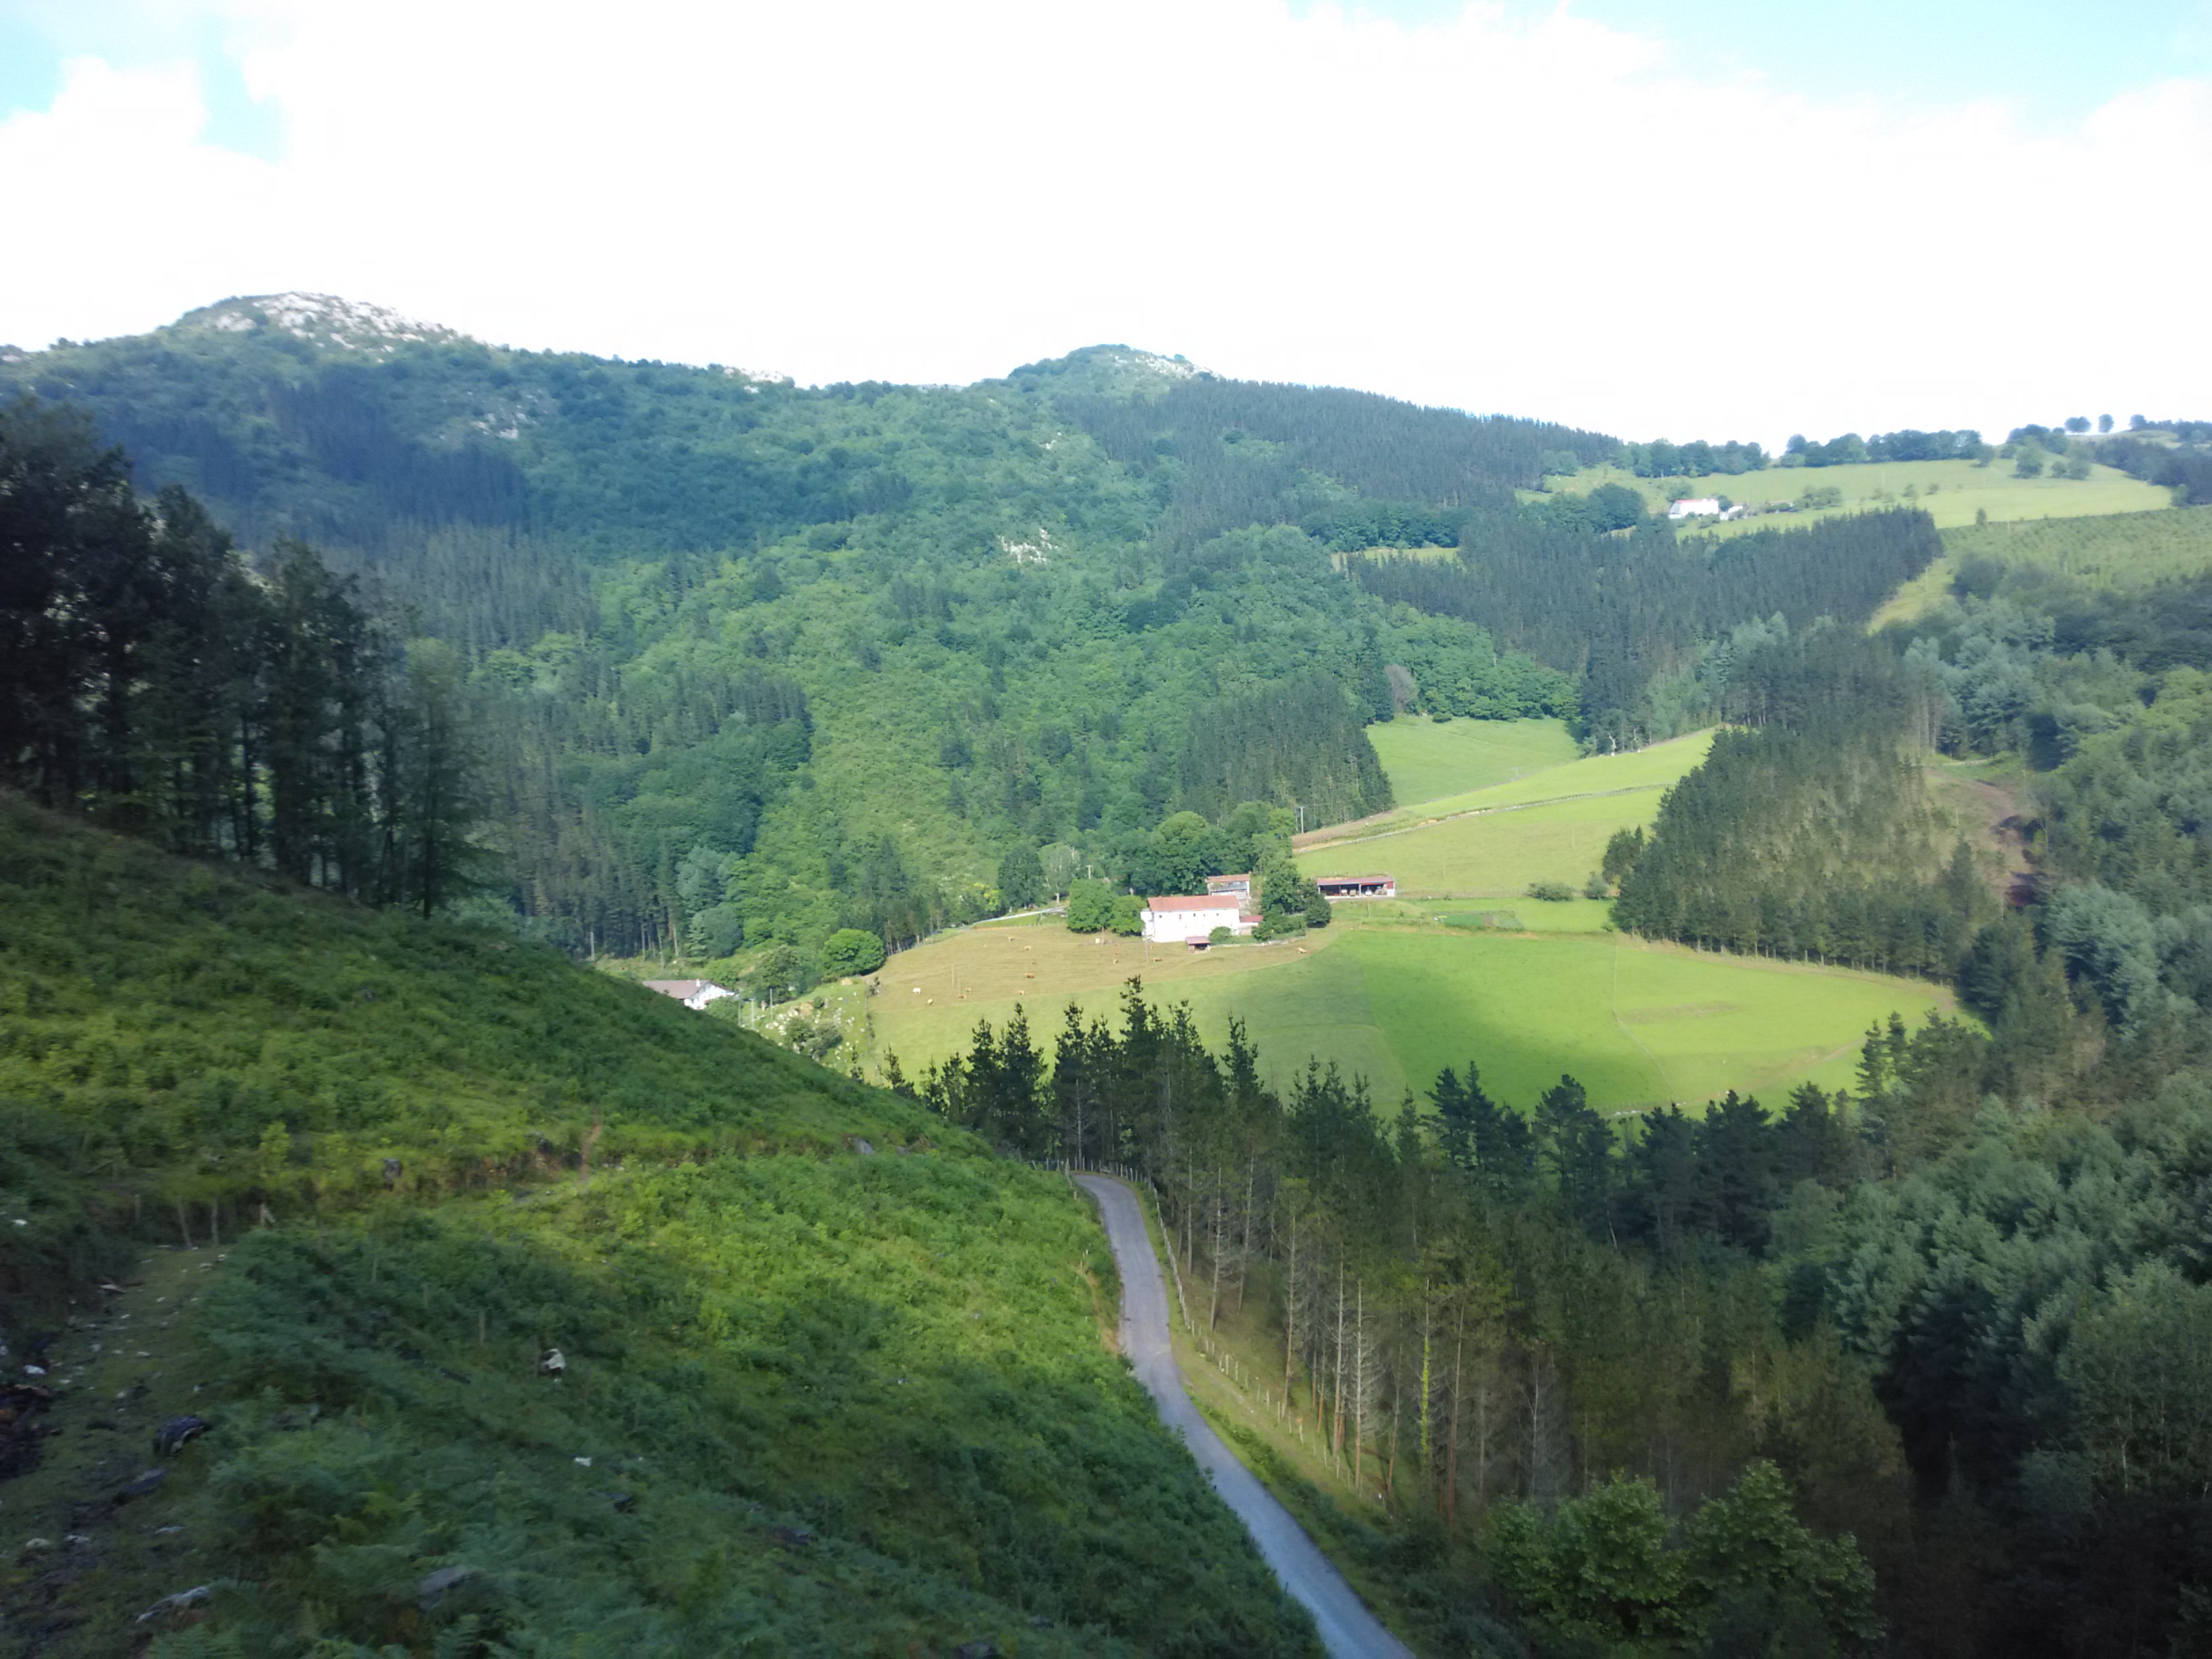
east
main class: Grassland
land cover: Grassland without tree/shrub cover
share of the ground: > 75 %
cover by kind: herbaceous plants 90 %, consolidated bare surface 10 %
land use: Agriculture (excluding fallow land and kitchen gardens)
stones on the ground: < 10 %
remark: Clear cut
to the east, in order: Grassland without tree/shrub cover; Paved roads, cycling and walking lanes; Fences; Pine dominated coniferous woodland
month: June
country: ES
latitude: 43.2297
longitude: -2.3262
